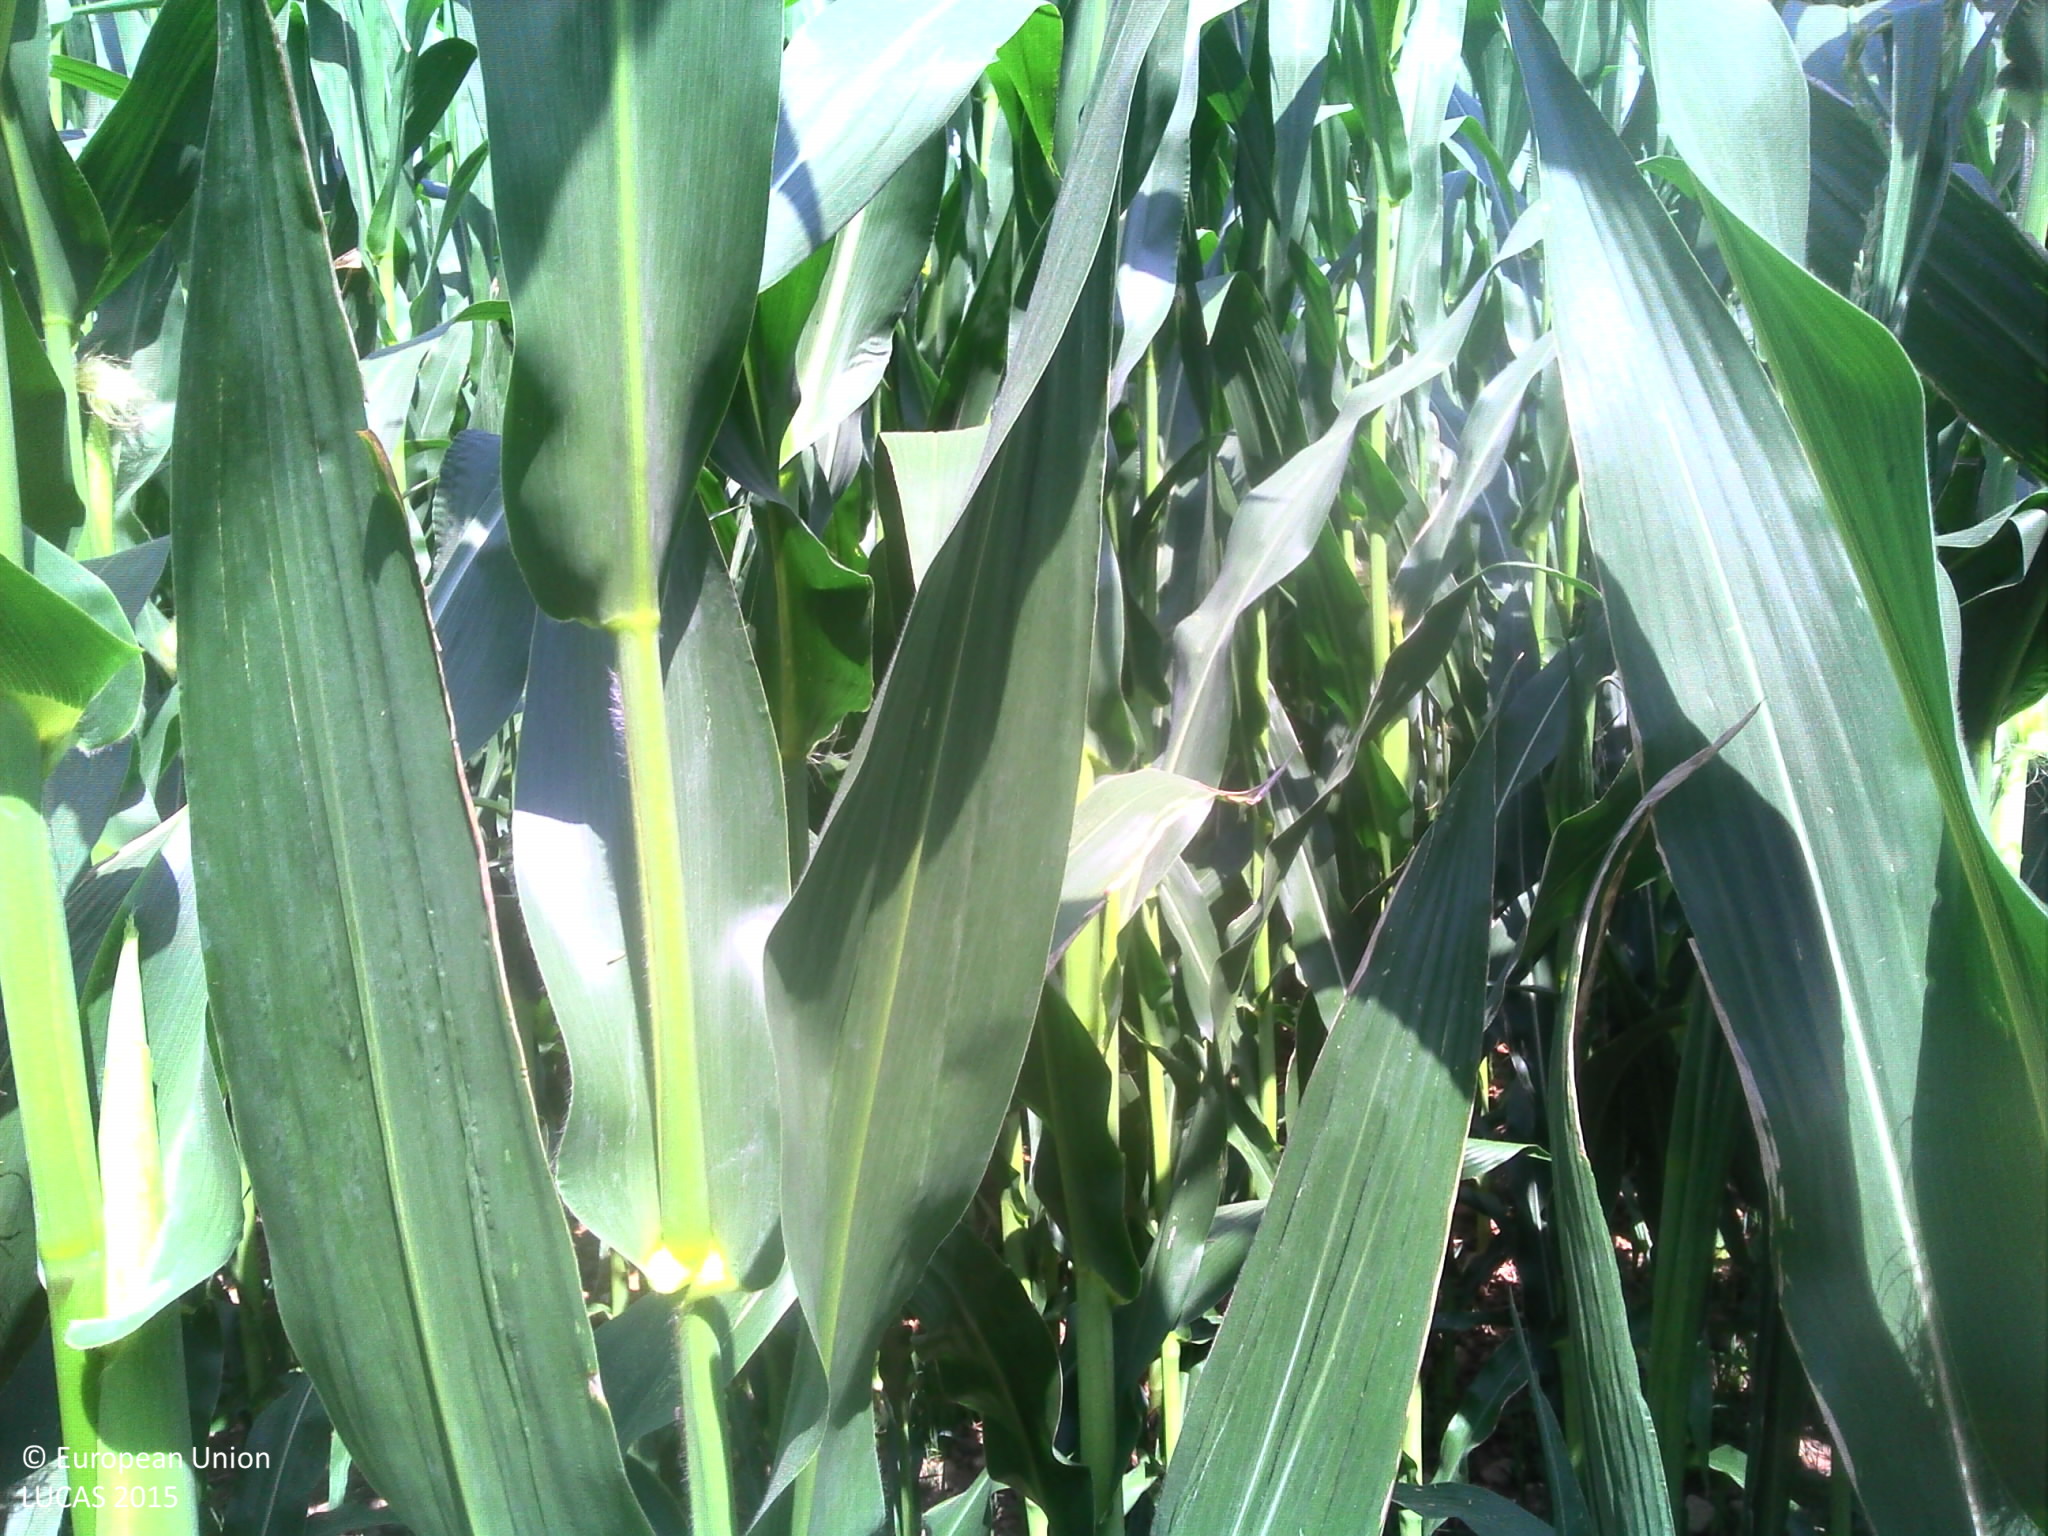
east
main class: Cropland
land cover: Maize
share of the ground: > 75 %
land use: Agriculture (excluding fallow land and kitchen gardens)
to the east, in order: Maize; Tracks; Maize; Electric lines; Maize; Grass margins; Paved roads, cycling and walking lanes; Grass margins; Electric lines; Maize; Electric lines; Maize
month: July
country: FR
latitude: 45.7195
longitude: 5.1861
